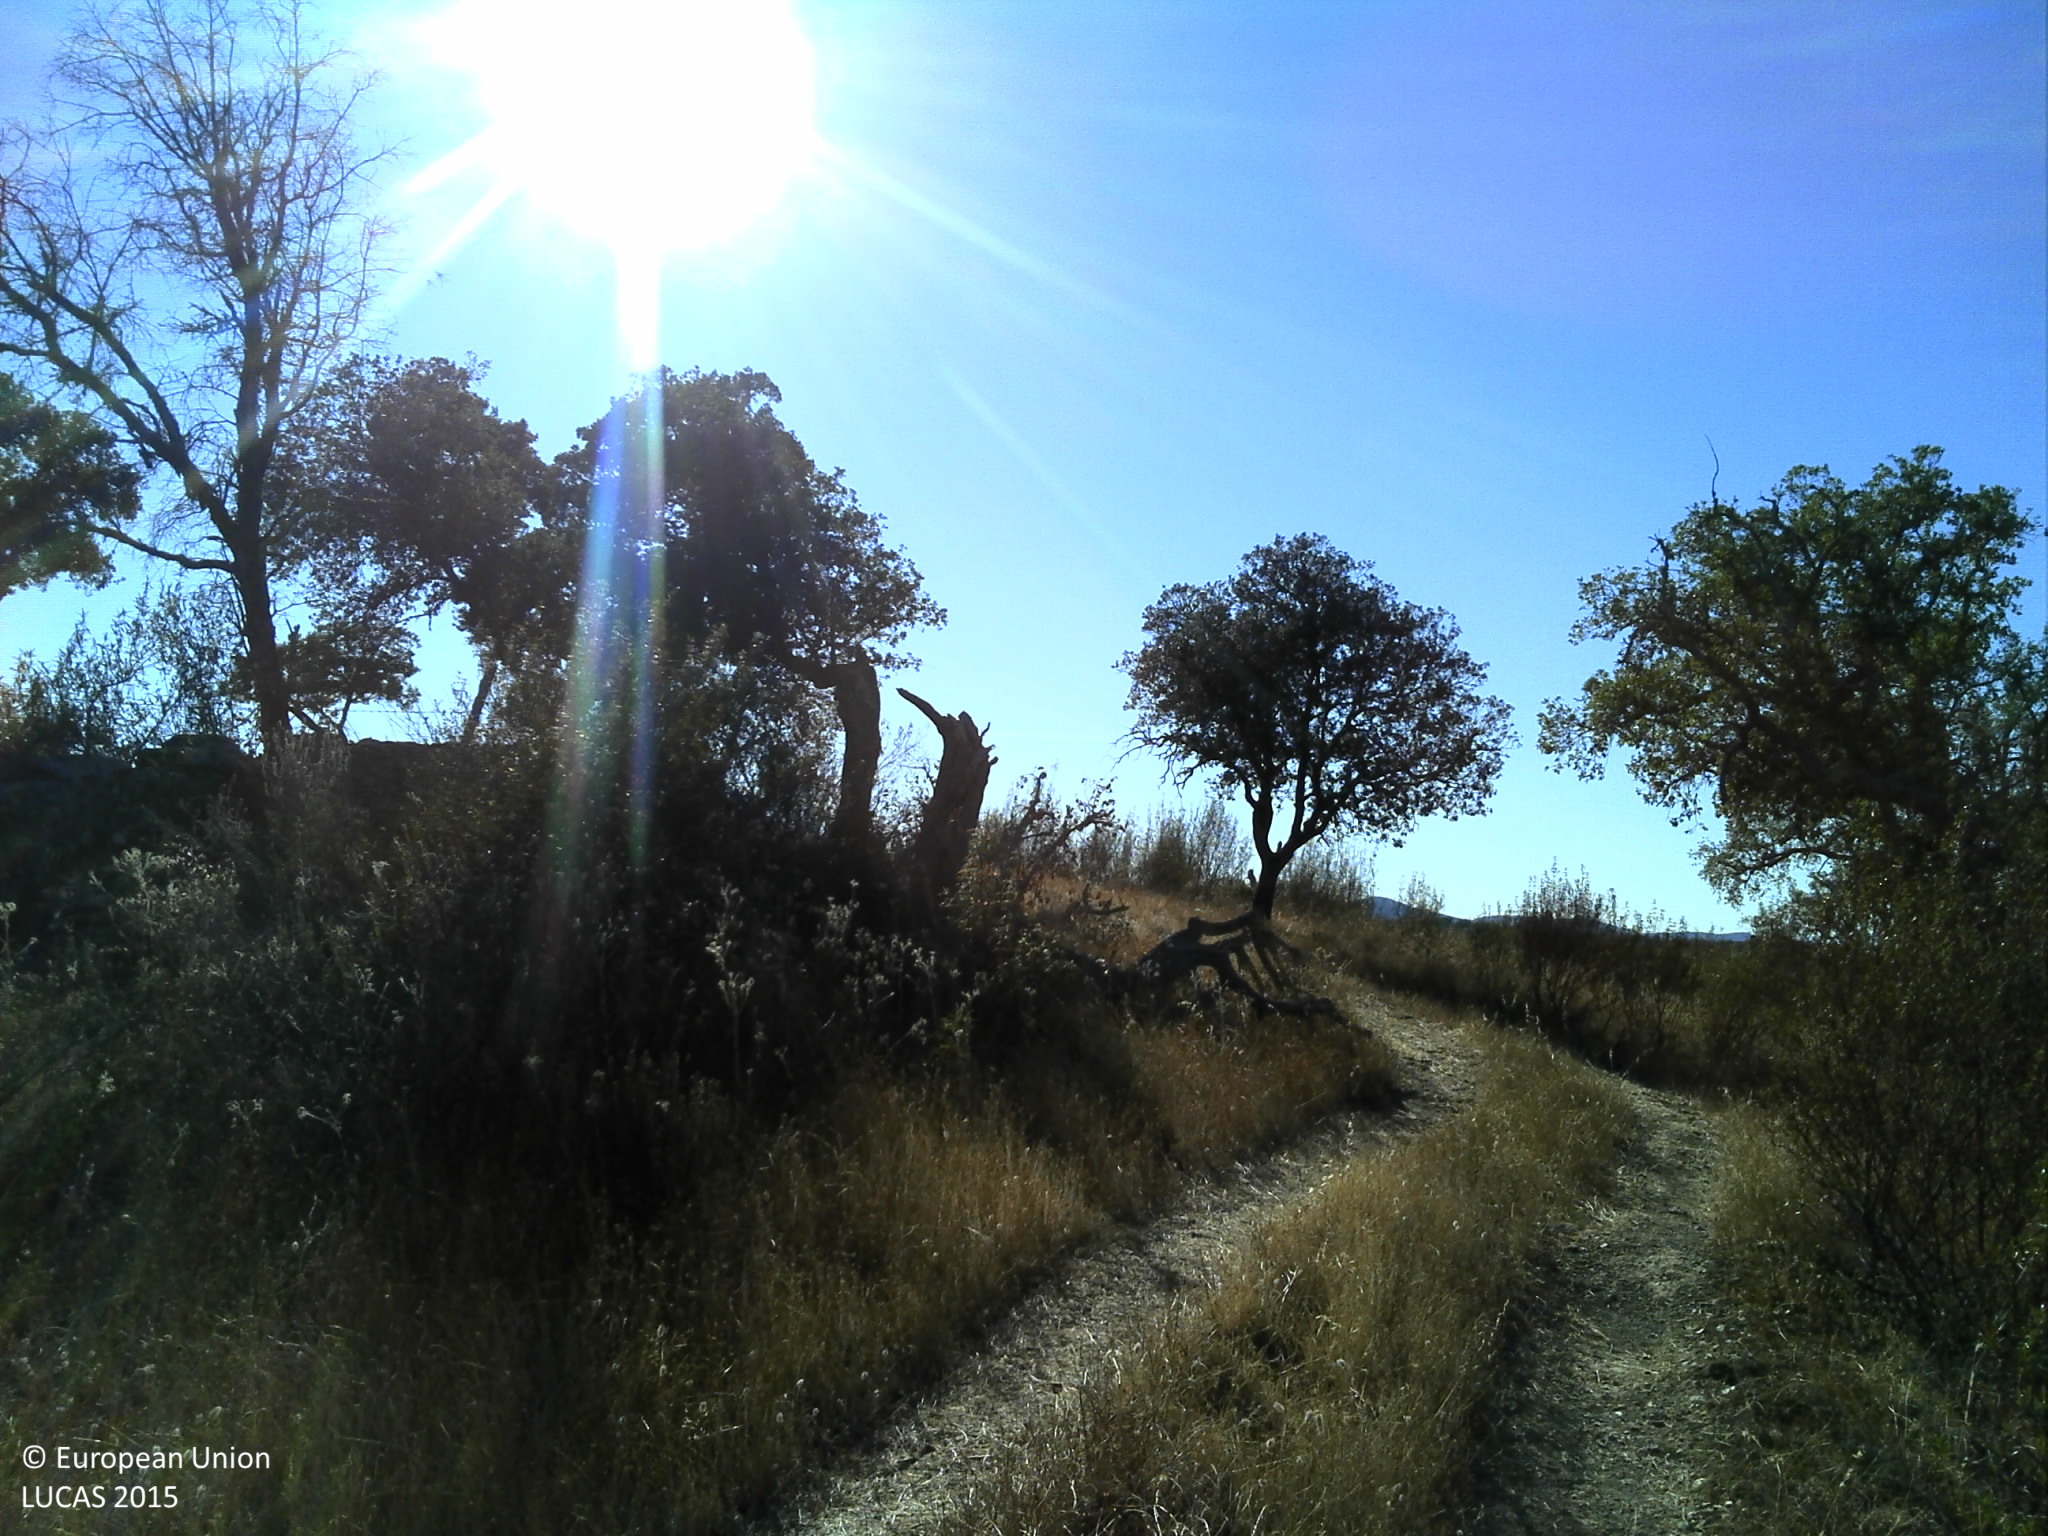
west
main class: Woodland
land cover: Broadleaved woodland
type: broadleaved evergreen forest
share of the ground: 10 - 25 %
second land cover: Shrubland without tree cover
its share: > 75 %
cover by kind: shrubs 85 %, broadleaved forest trees 15 %
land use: Forestry
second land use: Agriculture (excluding fallow land and kitchen gardens)
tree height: > 5 m
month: August
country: PT
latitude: 39.5415
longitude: -7.5371
